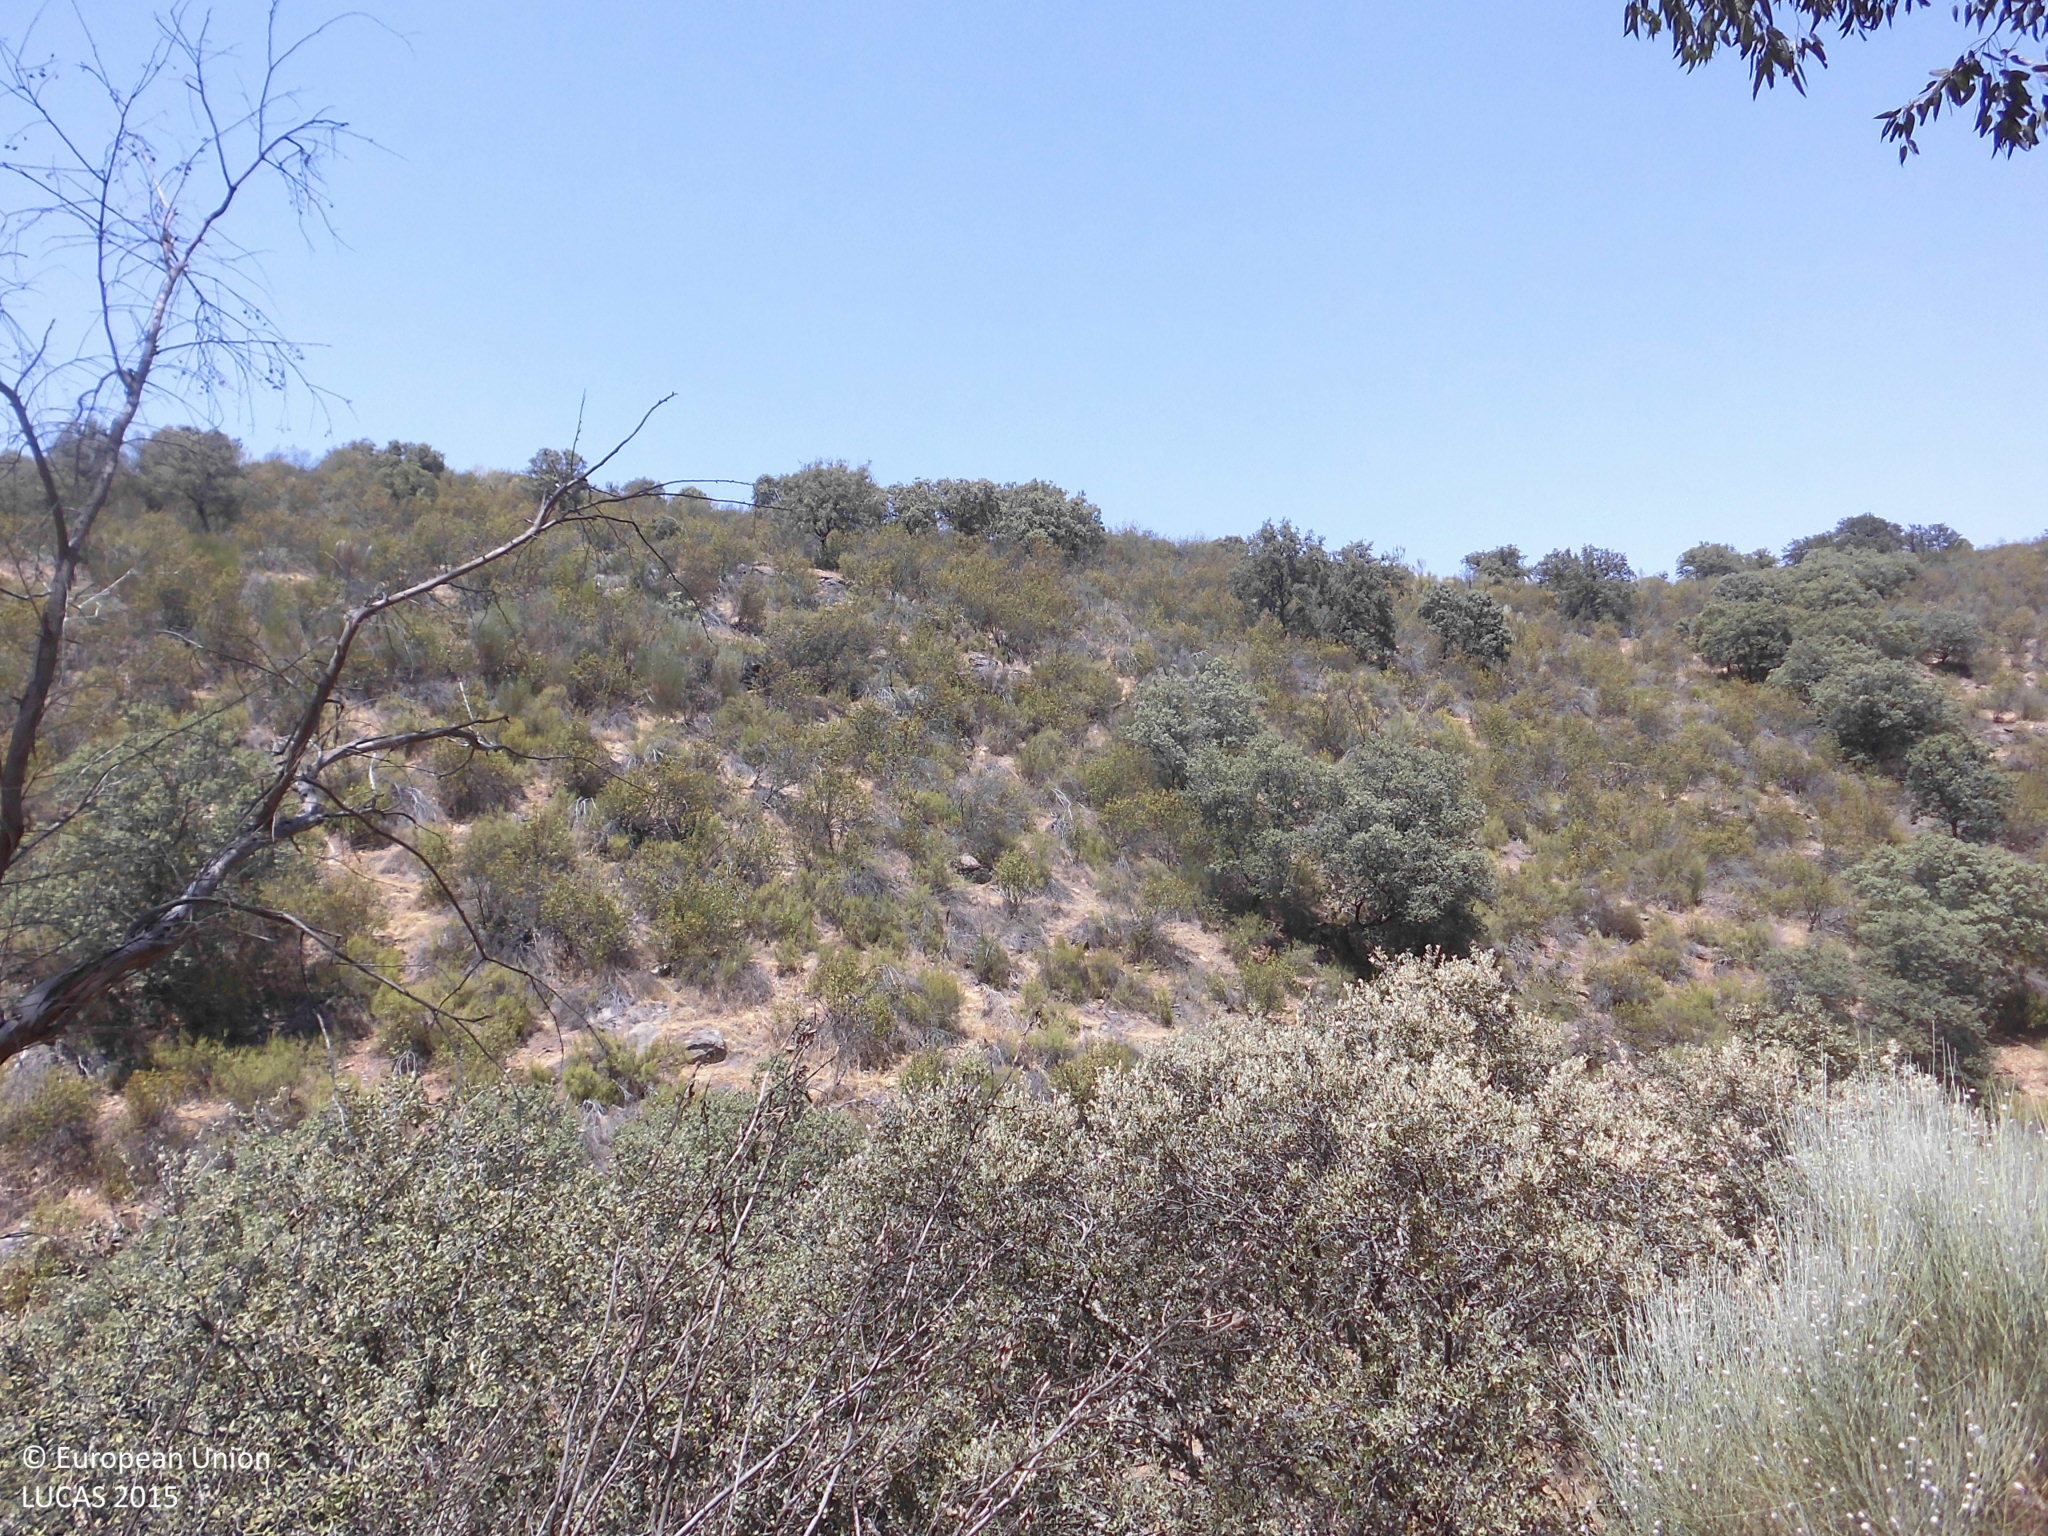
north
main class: Woodland
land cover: Broadleaved woodland
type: exotic forest
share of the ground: 50 - 75 %
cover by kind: broadleaved forest trees 75 %, shrubs 20 %, herbaceous plants 5 %
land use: Forestry
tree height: > 5 m
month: July
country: ES
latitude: 39.7205
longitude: -5.4179
